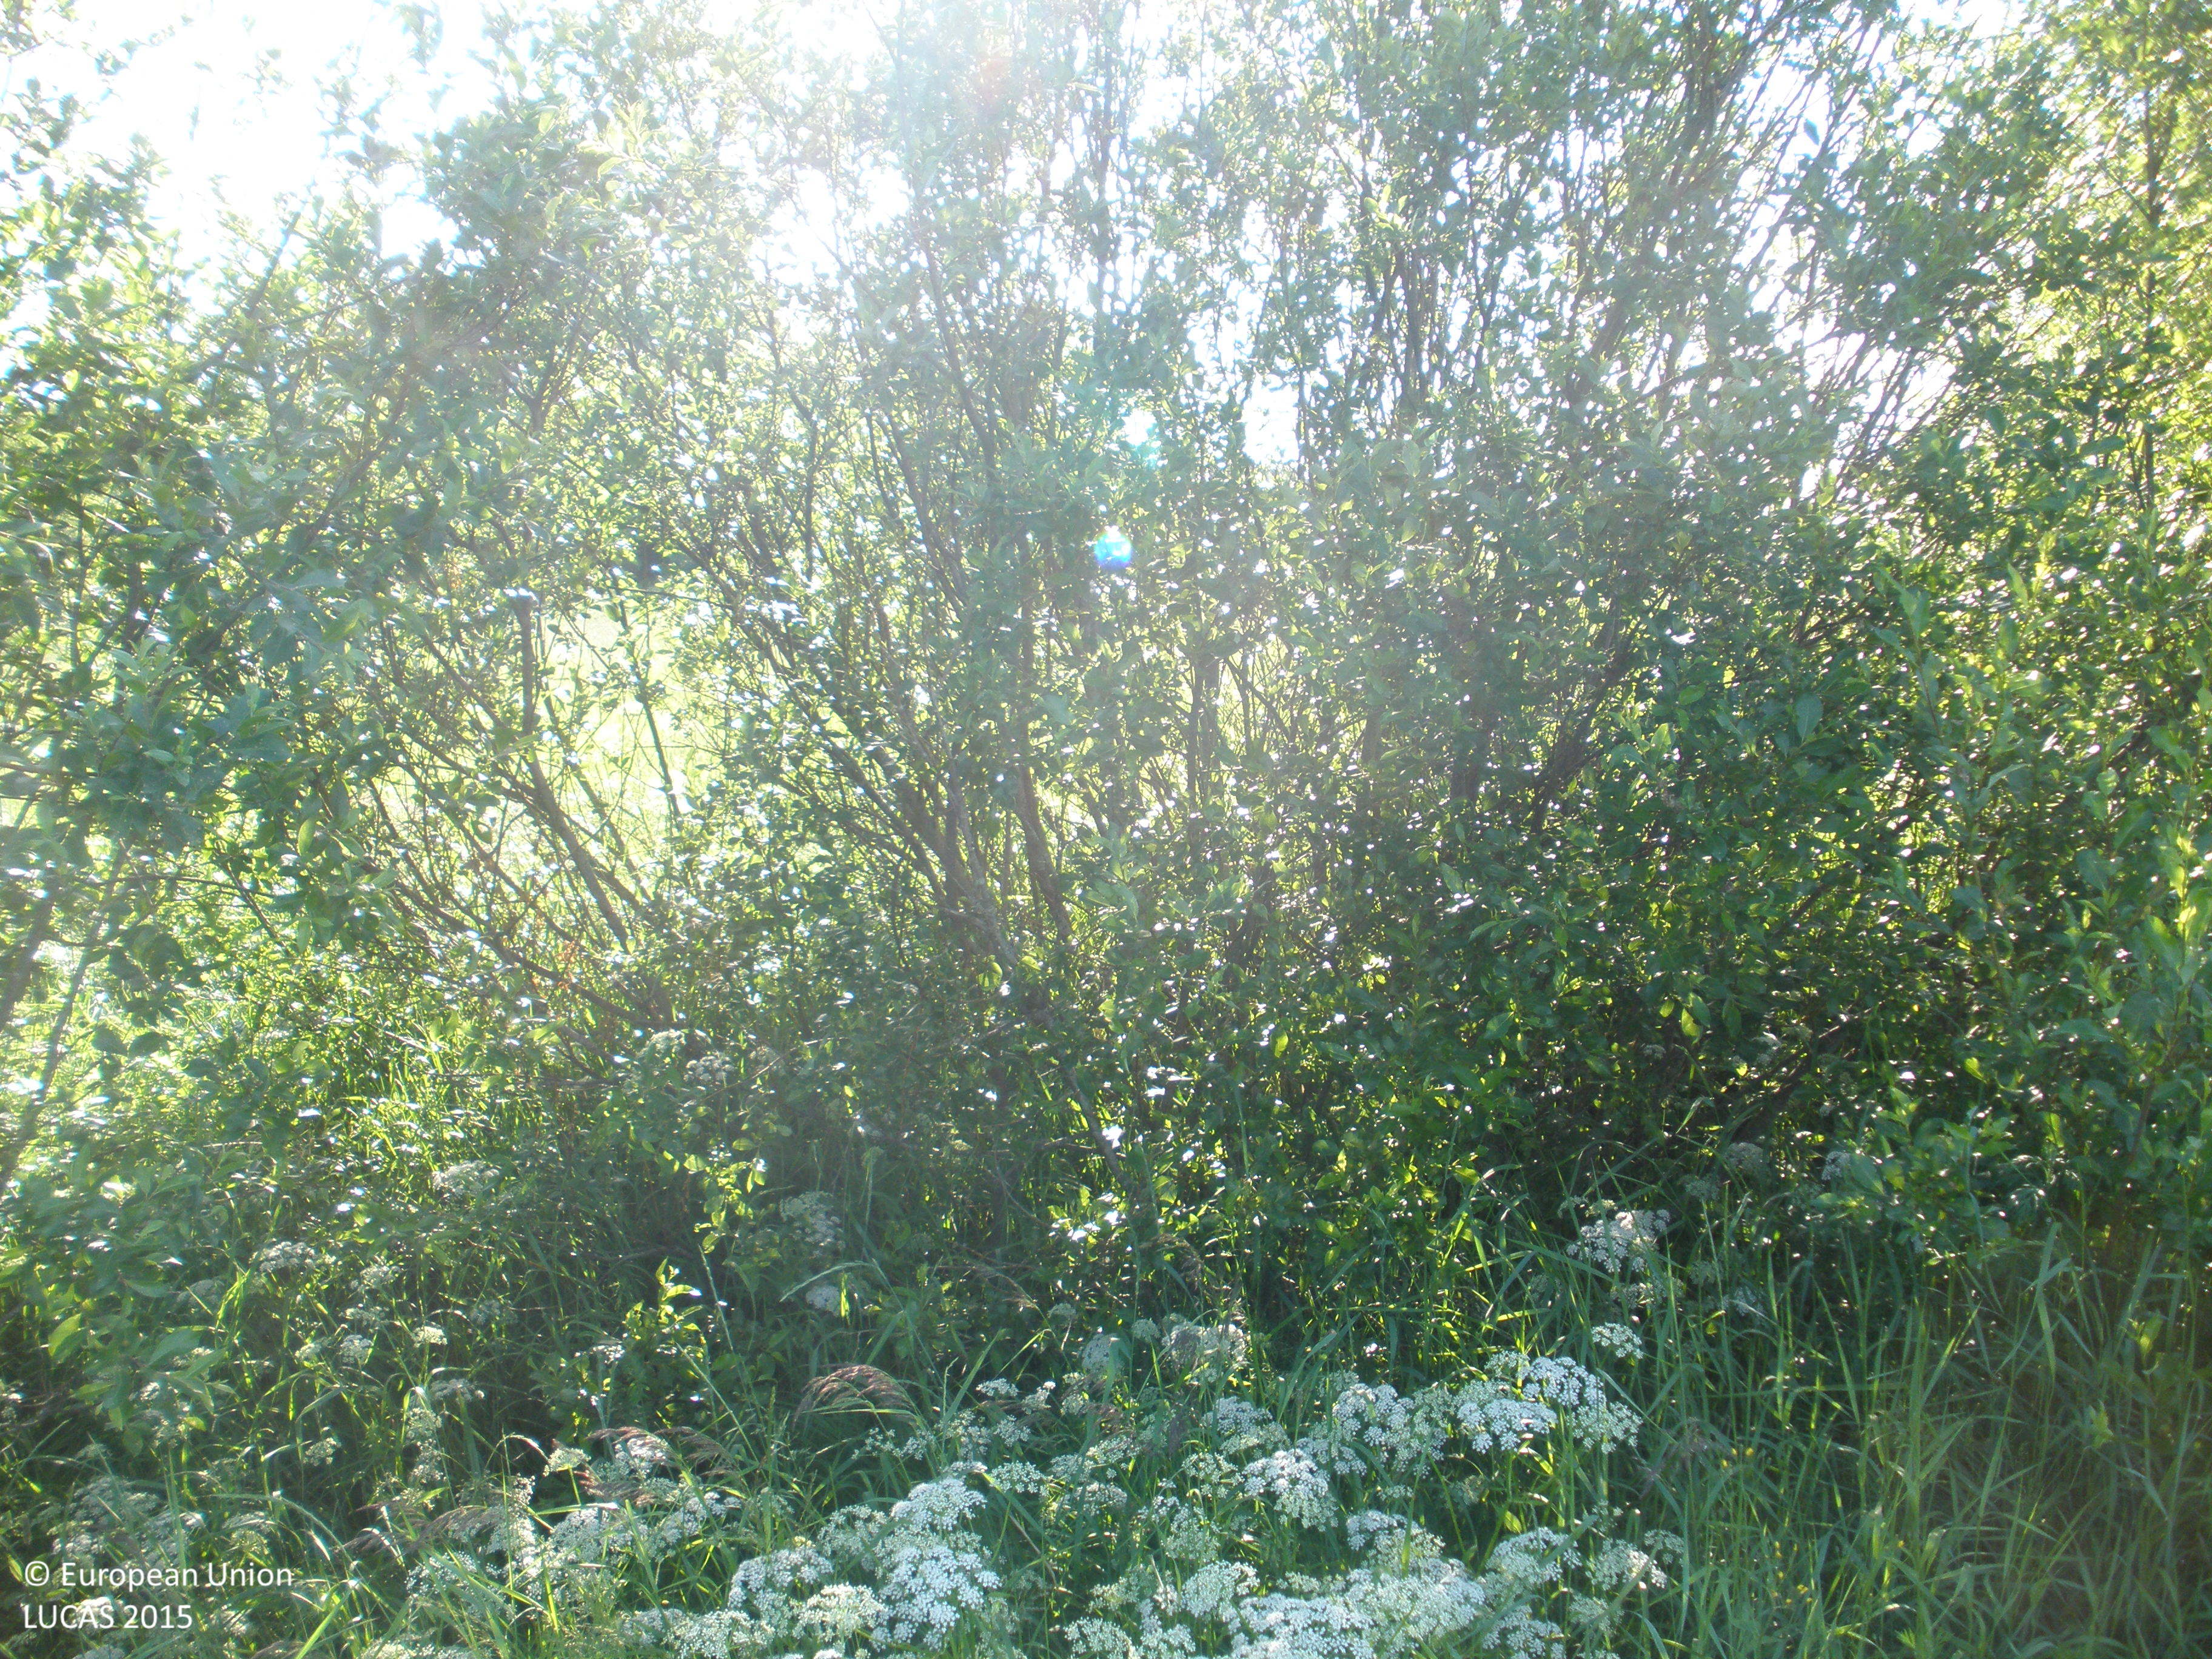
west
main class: Cropland
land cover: Common wheat
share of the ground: > 75 %
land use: Agriculture (excluding fallow land and kitchen gardens)
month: July
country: FI
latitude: 61.1704
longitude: 23.9399
